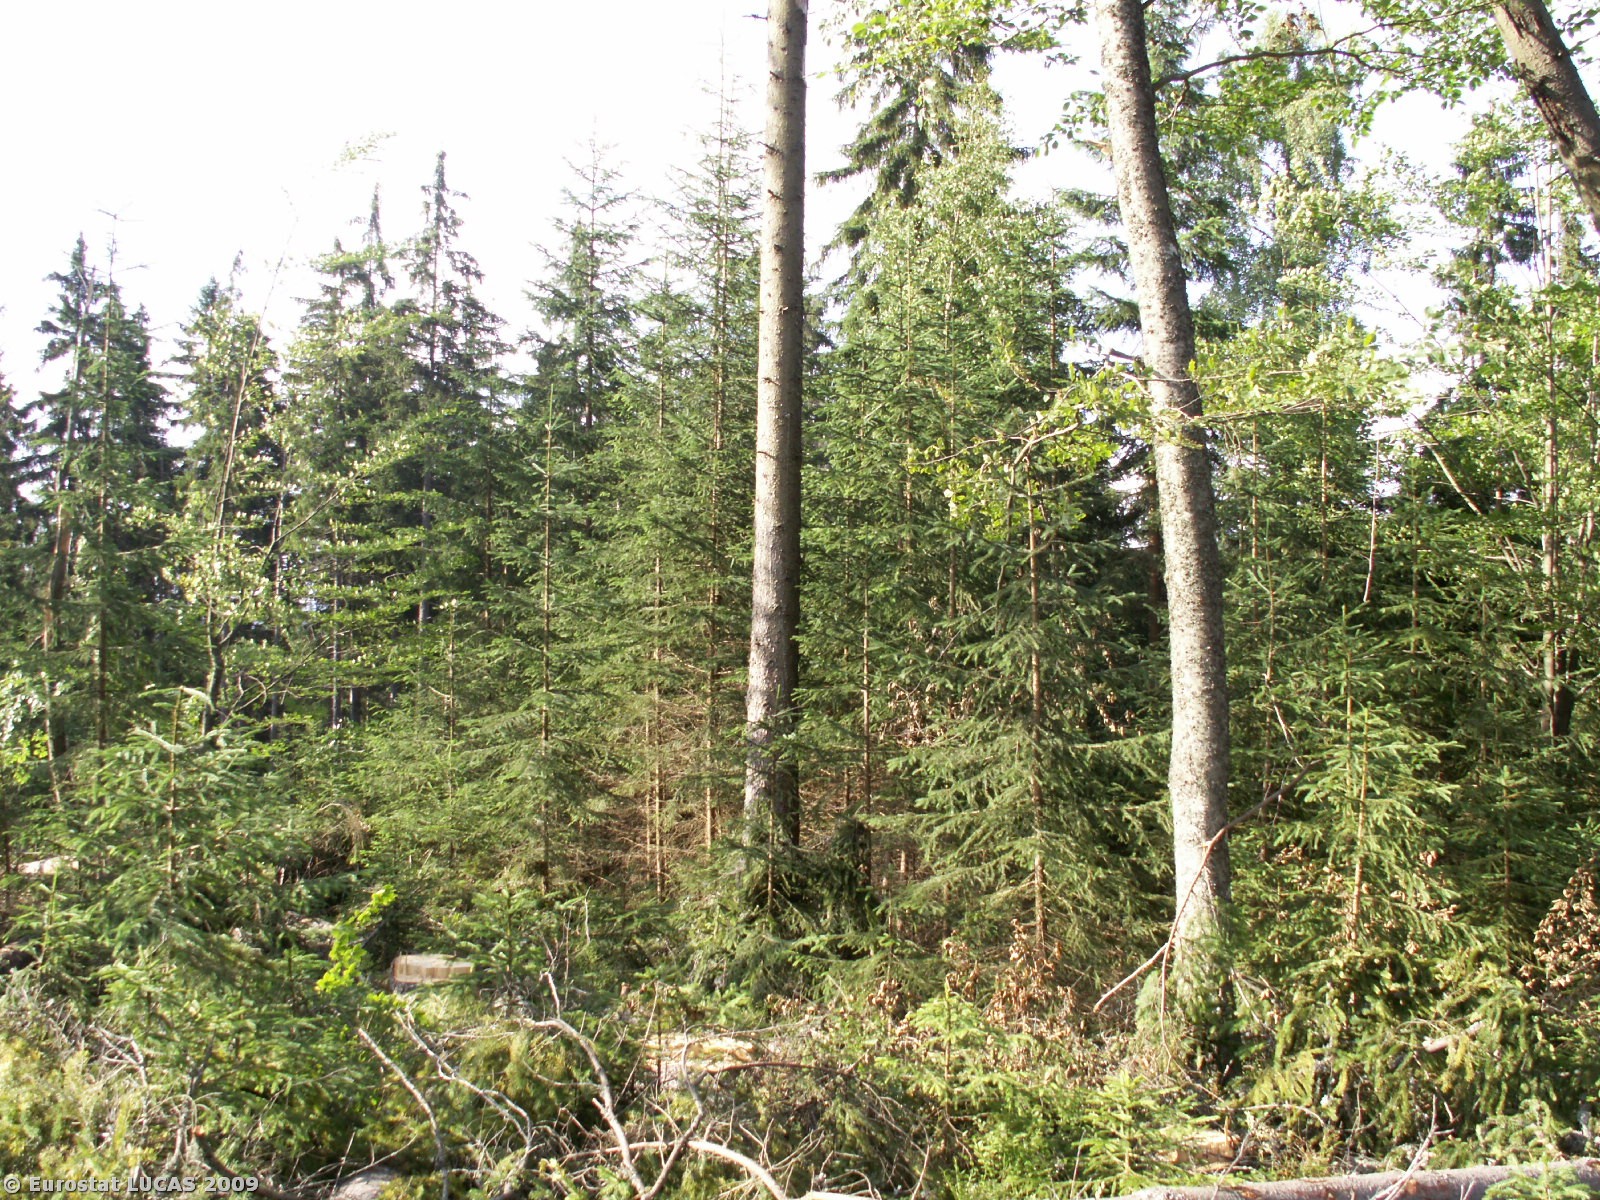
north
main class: Woodland
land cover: Coniferous woodland
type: hemiboreal forest and nemoral coniferous forest and mixed broadleaved-coniferous forest
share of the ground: > 75 %
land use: Forestry
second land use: Nature reserves
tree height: > 5 m
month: July
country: CZ
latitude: 48.8056
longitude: 13.8261
